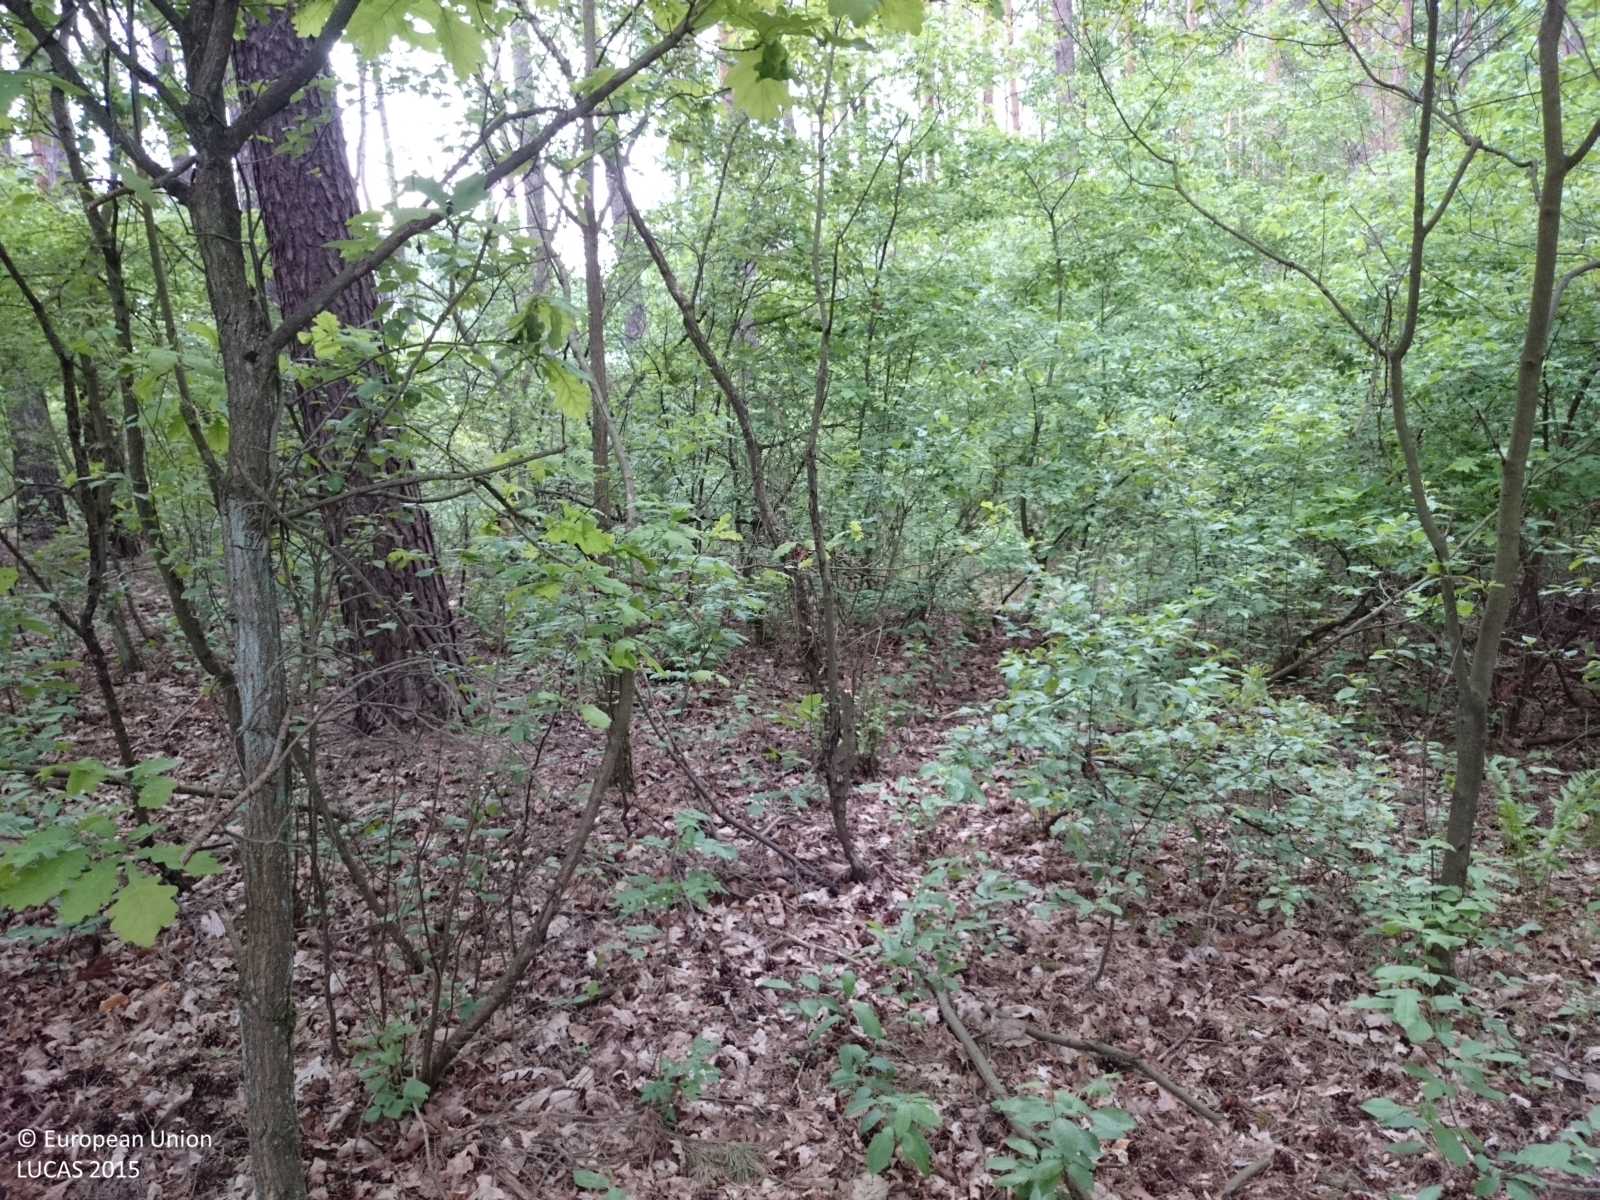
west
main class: Woodland
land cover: Pine dominated mixed woodland
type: hemiboreal forest and nemoral coniferous forest and mixed broadleaved-coniferous forest
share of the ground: > 75 %
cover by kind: coniferous forest trees 75 %, broadleaved forest trees 25 %
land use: Forestry
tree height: > 5 m
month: May
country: PL
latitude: 52.6029
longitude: 15.6595
